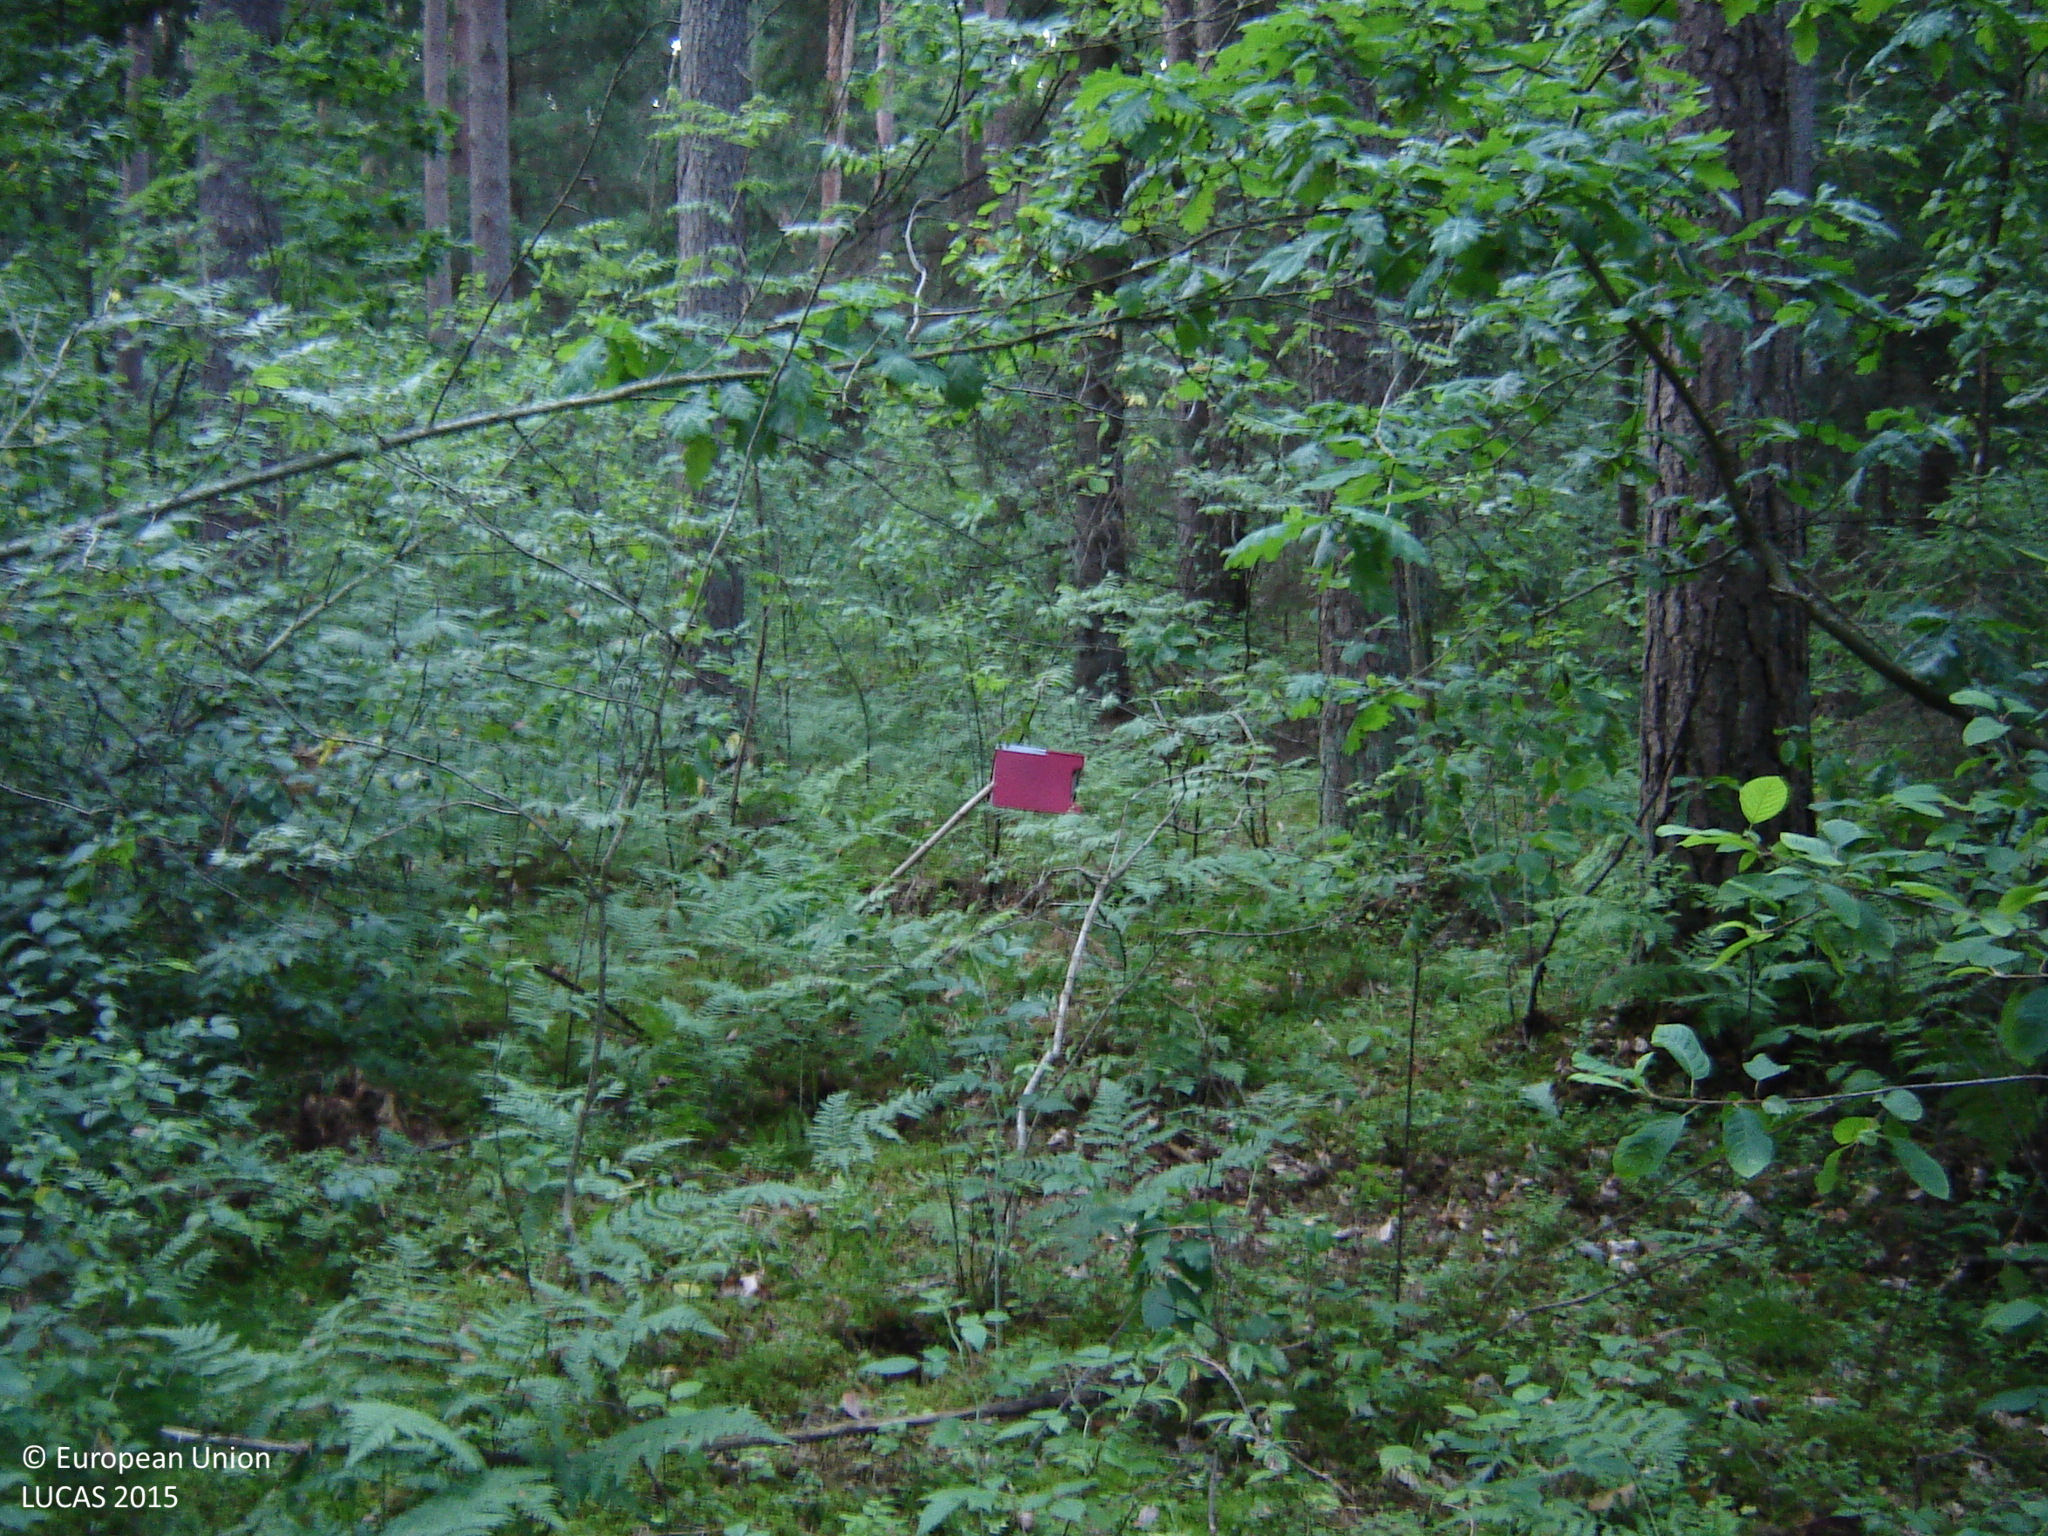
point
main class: Woodland
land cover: Pine dominated coniferous woodland
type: hemiboreal forest and nemoral coniferous forest and mixed broadleaved-coniferous forest
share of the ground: > 75 %
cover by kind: coniferous forest trees 80 %, broadleaved forest trees 10 %, herbaceous plants 5 %, lichens and mosses 5 %
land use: Forestry
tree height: > 5 m
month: July
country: LT
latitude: 55.5093
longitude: 25.0772
